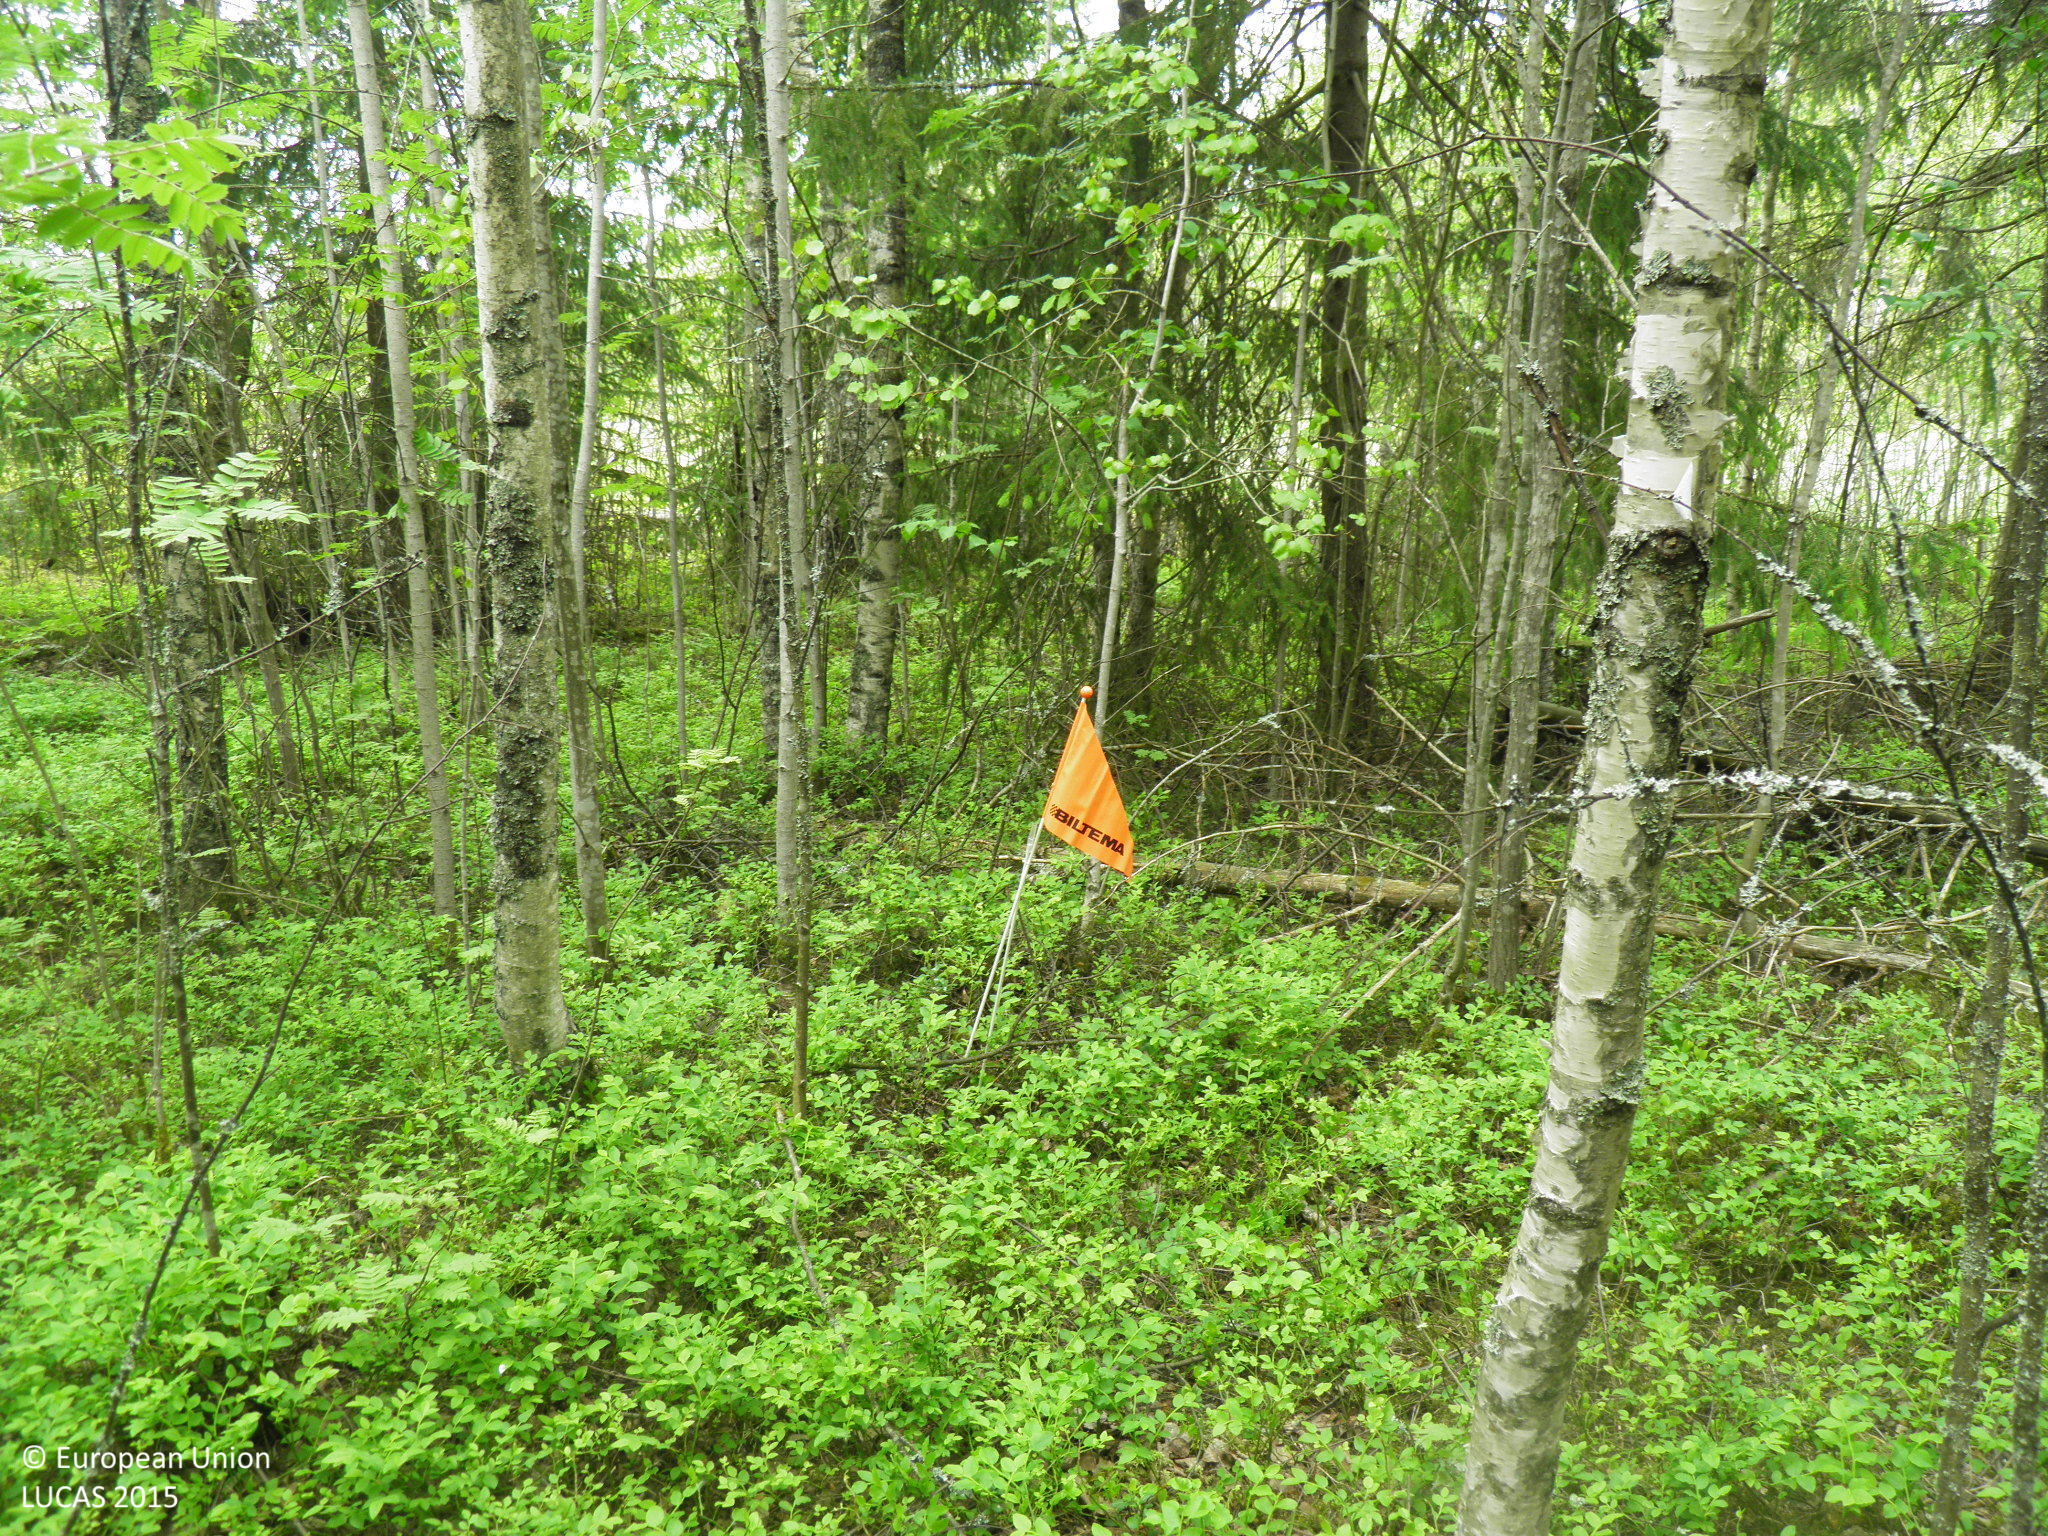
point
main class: Woodland
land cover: Other mixed woodland
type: boreal forest
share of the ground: > 75 %
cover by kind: coniferous forest trees 55 %, broadleaved forest trees 35 %, shrubs 5 %, herbaceous plants 5 %
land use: Forestry
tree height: > 5 m
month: June
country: FI
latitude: 60.4384
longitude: 21.9282
